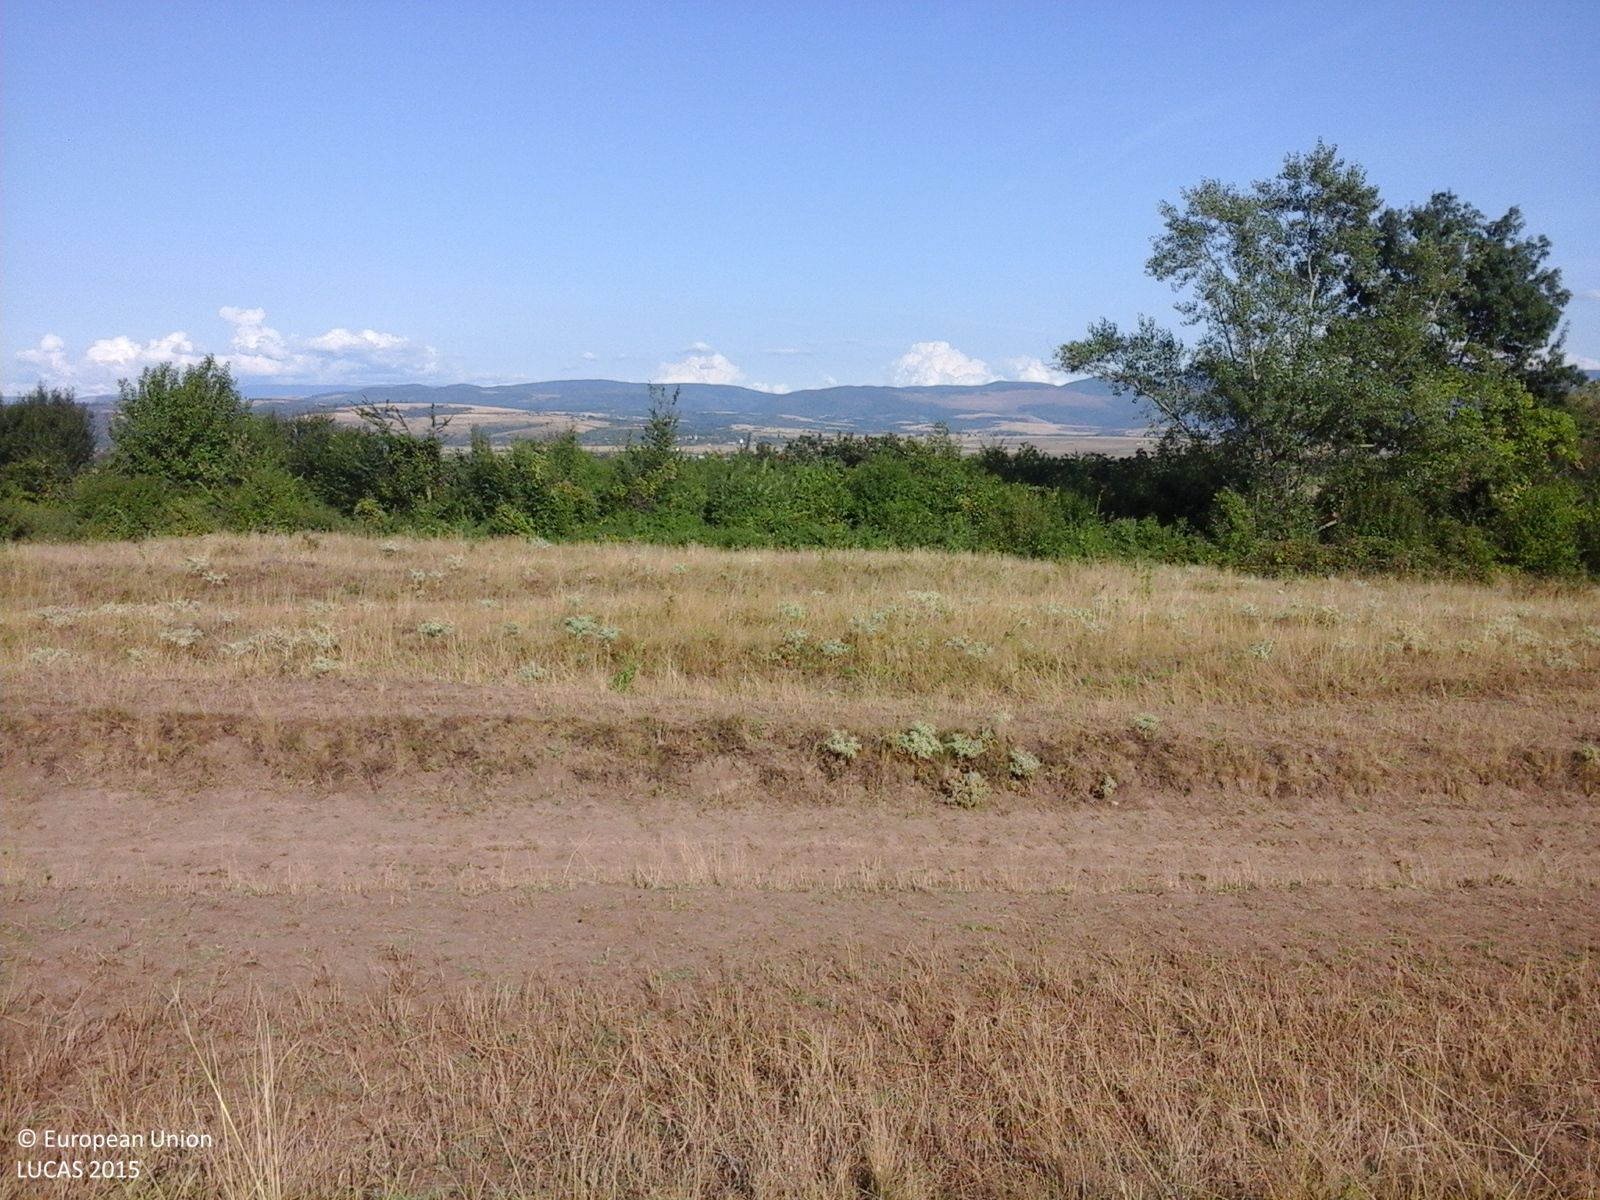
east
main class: Grassland
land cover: Spontaneously vegetated surfaces
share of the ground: > 75 %
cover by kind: herbaceous plants 100 %
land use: Semi-natural and natural areas not in use
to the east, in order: Spontaneously vegetated surfaces; Tracks; Spontaneously vegetated surfaces; Broadleaved woodland; Grassland with sparse tree/shrub cover; Artificial constructions in urban areas
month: August
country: RO
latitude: 45.1189
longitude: 21.5863
